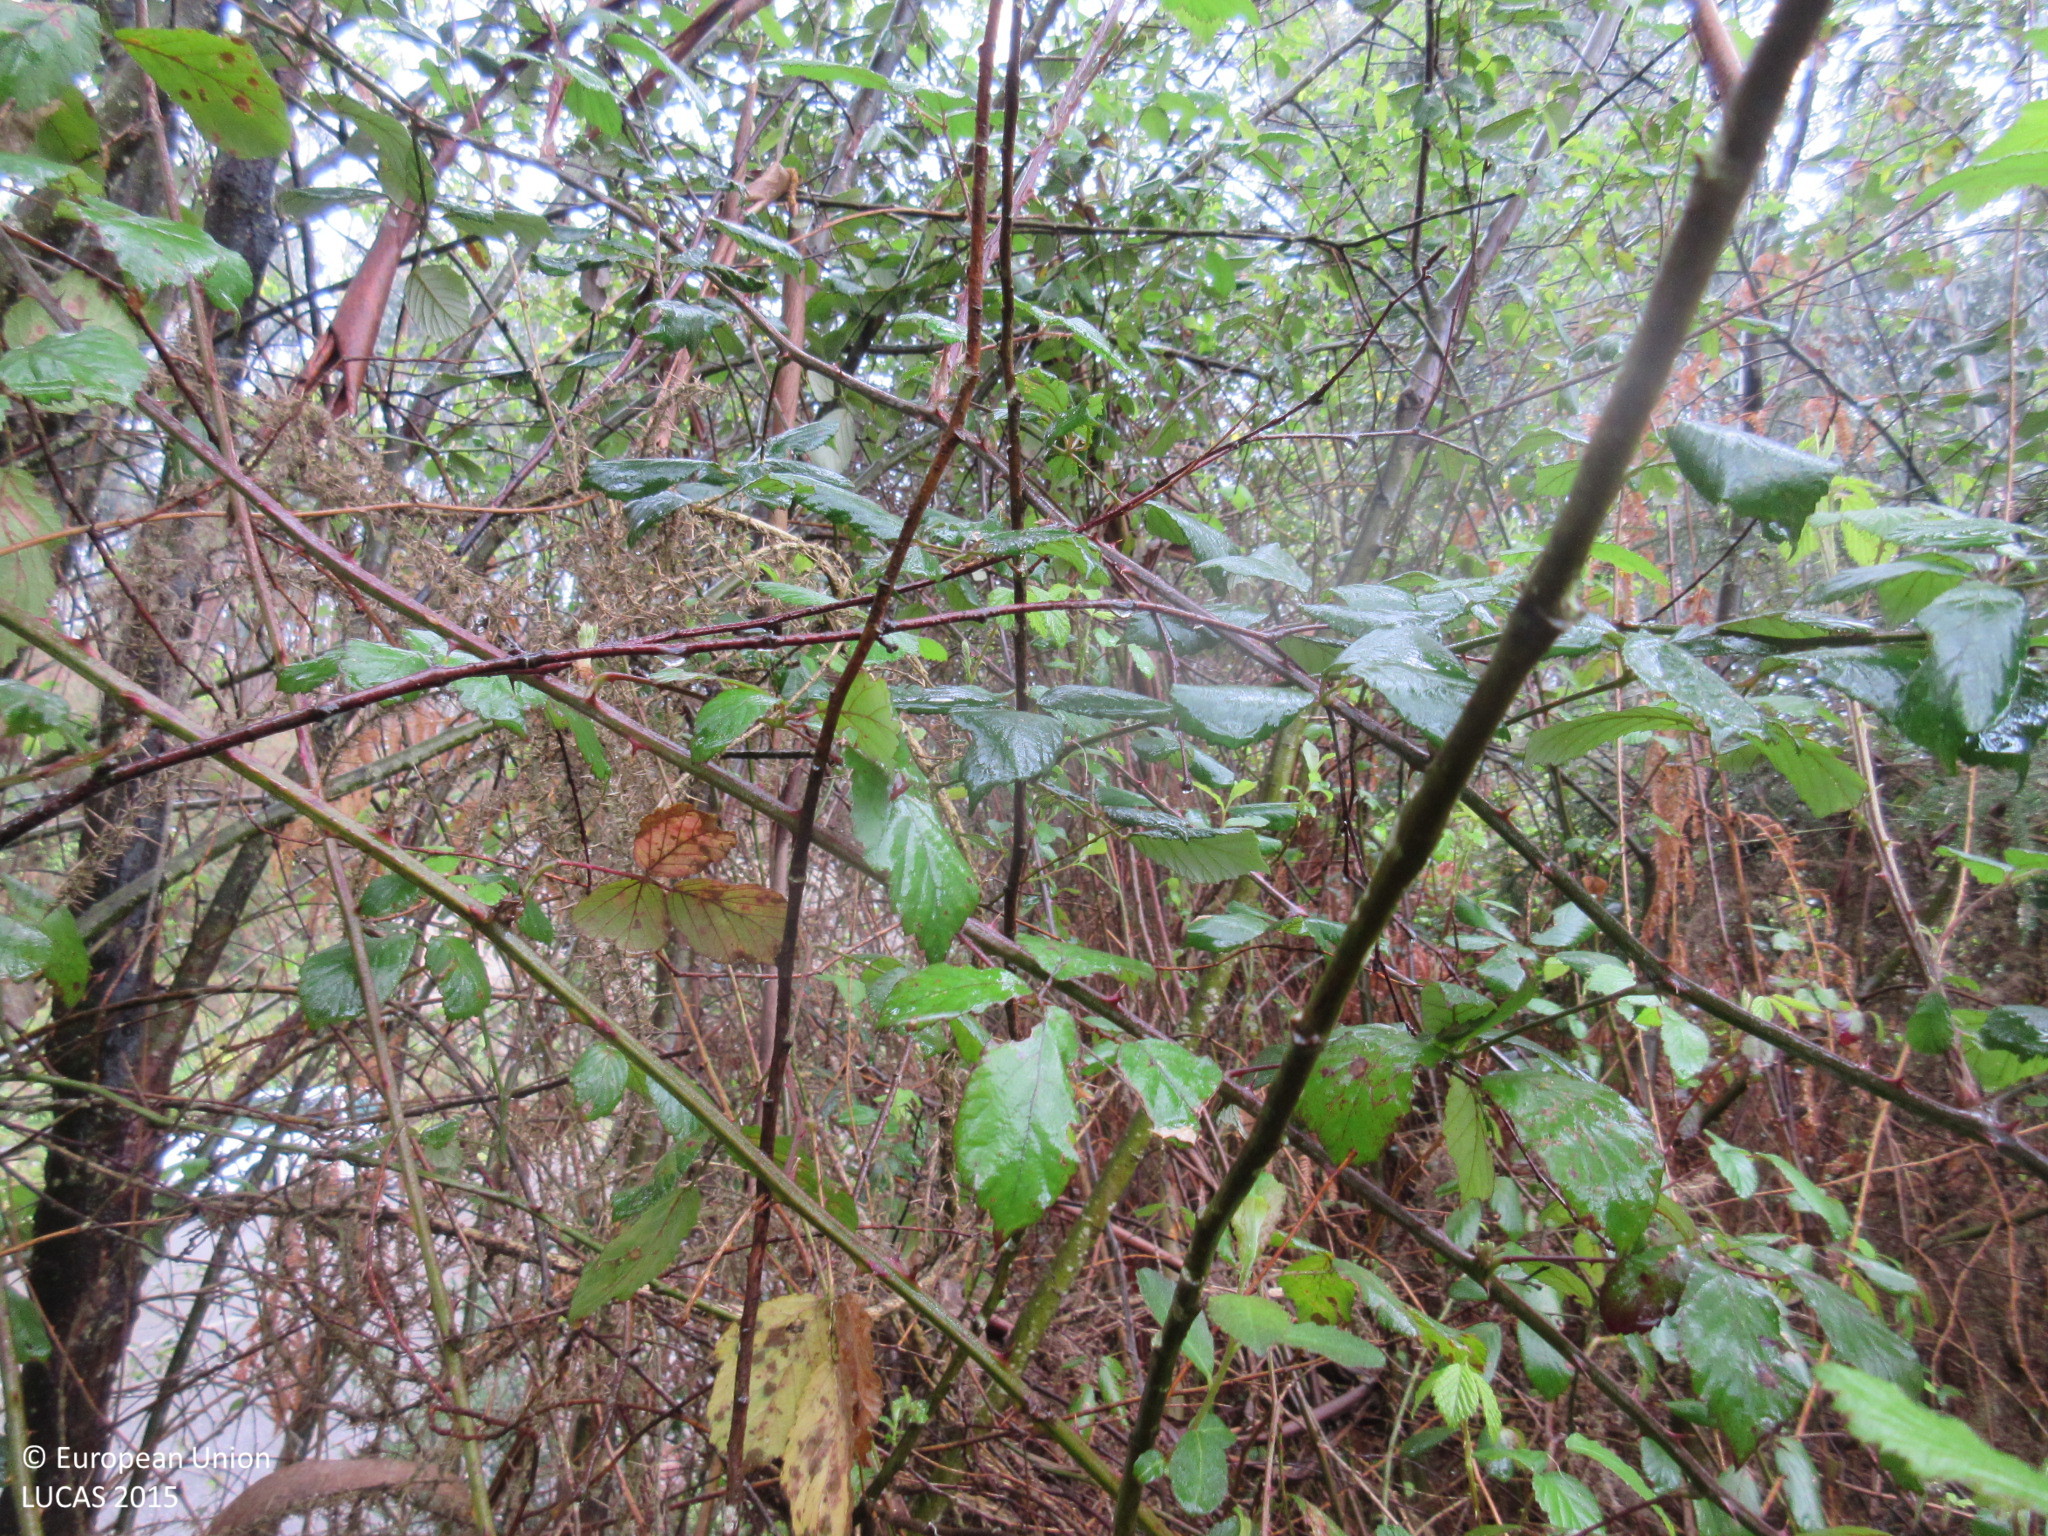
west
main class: Woodland
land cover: Broadleaved woodland
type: exotic forest
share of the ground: > 75 %
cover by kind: broadleaved forest trees 90 %, shrubs 10 %
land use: Forestry
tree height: > 5 m
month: April
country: ES
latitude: 43.5046
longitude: -5.2777
